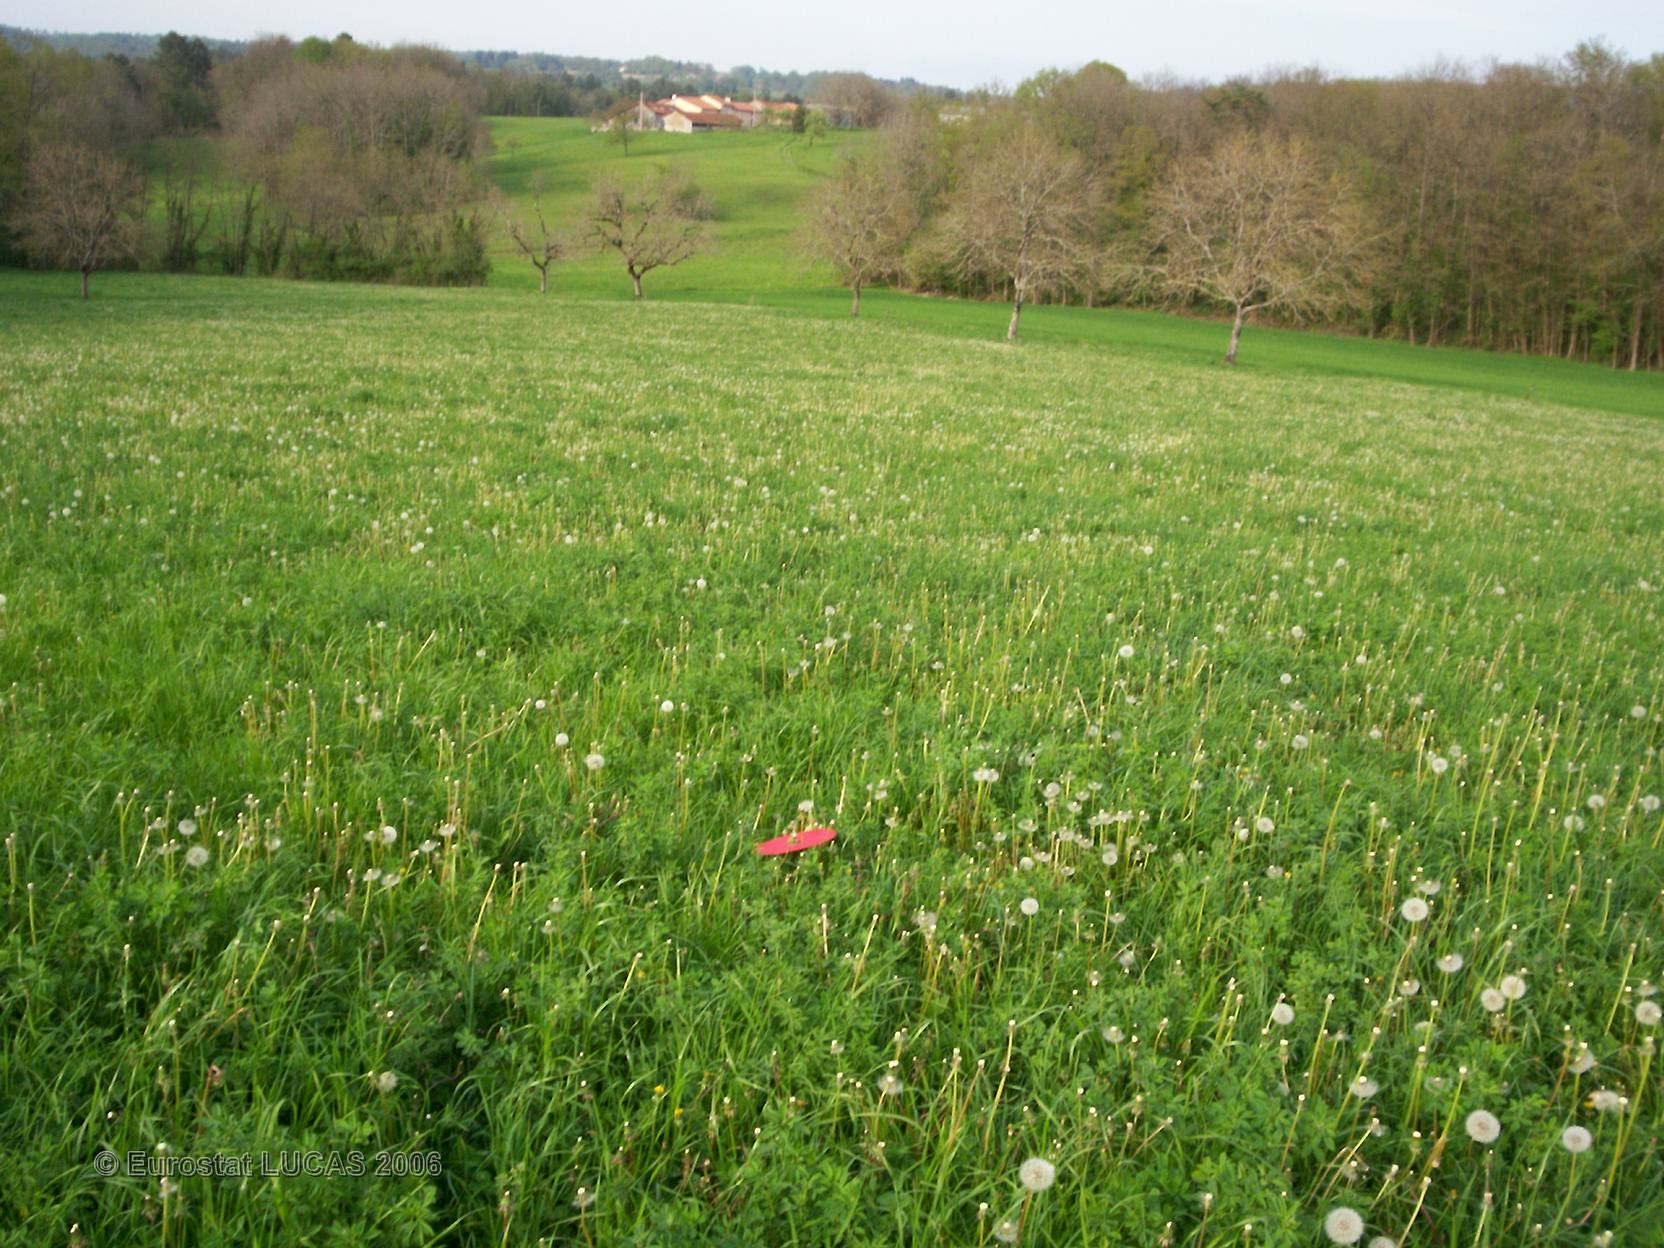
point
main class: Grassland
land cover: Grassland without tree/shrub cover
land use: Agriculture (excluding fallow land and kitchen gardens)
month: April
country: FR
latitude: 45.4797
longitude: 0.7653
